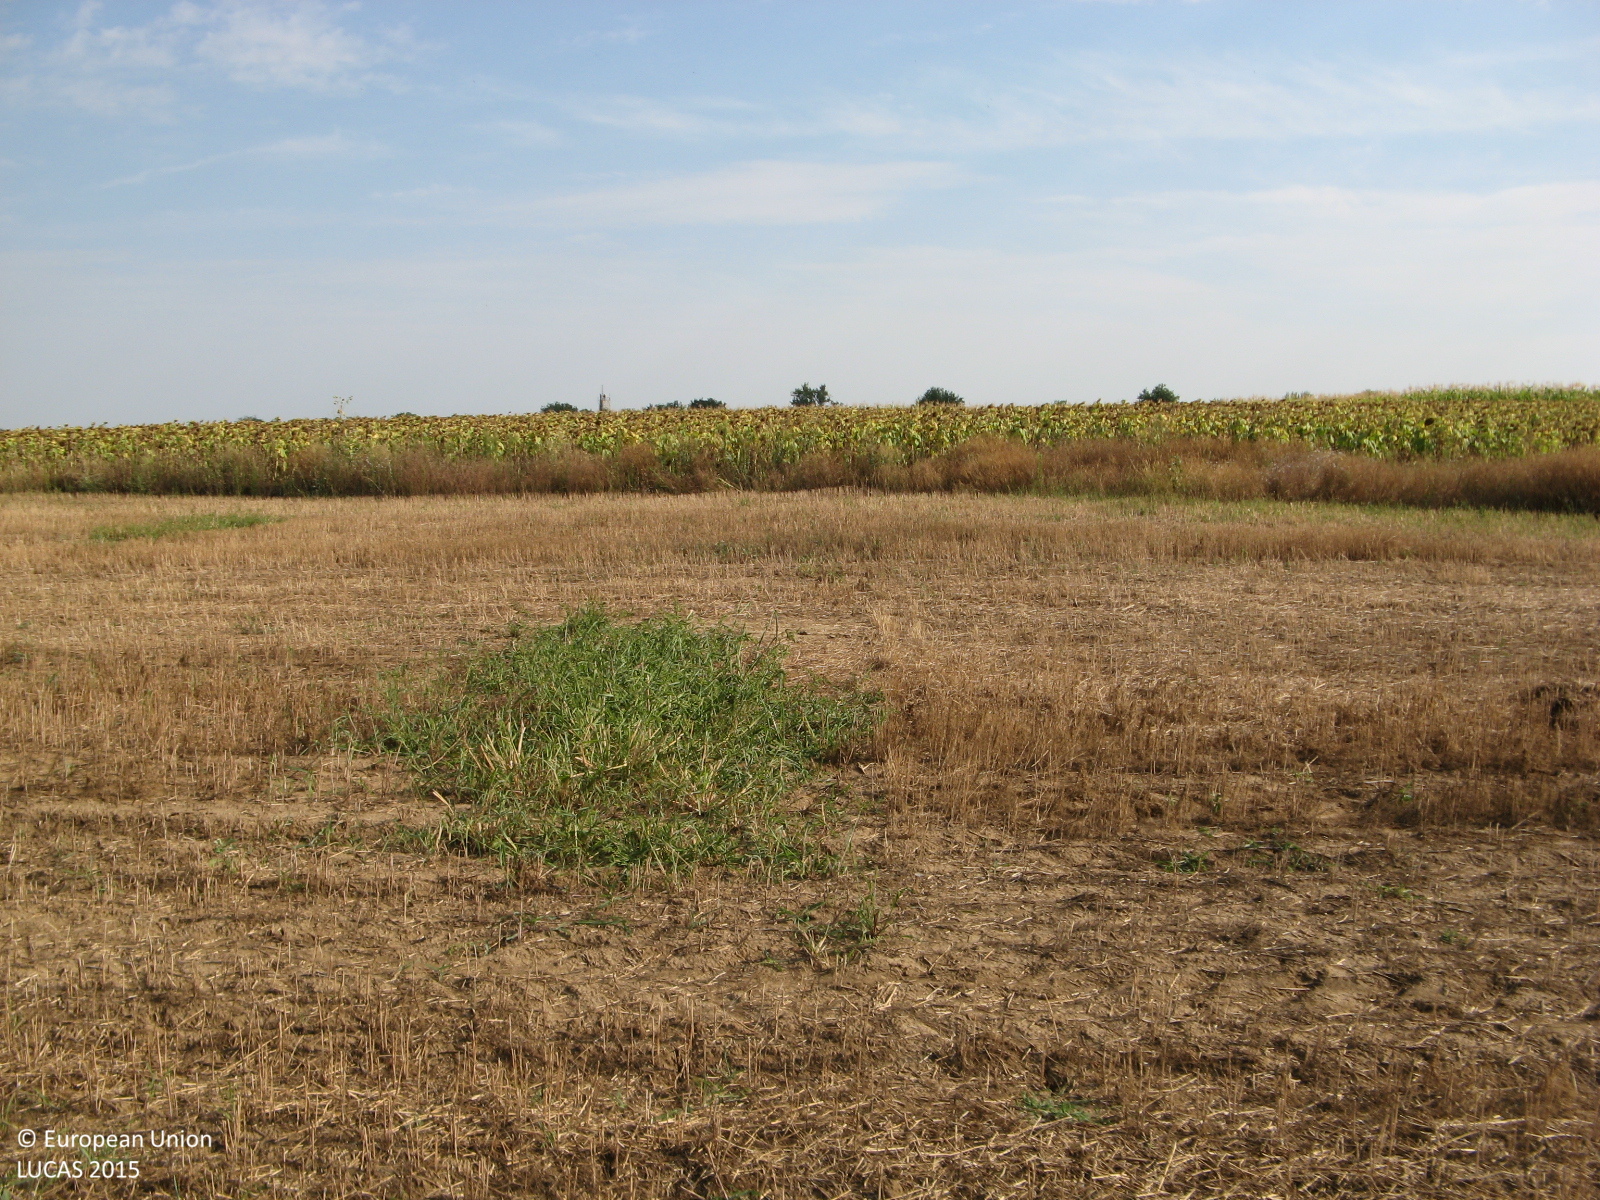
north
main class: Cropland
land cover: Other fibre and oleaginous crops
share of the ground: 25 - 50 %
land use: Agriculture (excluding fallow land and kitchen gardens)
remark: Harvested field
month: August
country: BG
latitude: 43.5711
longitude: 25.8017
